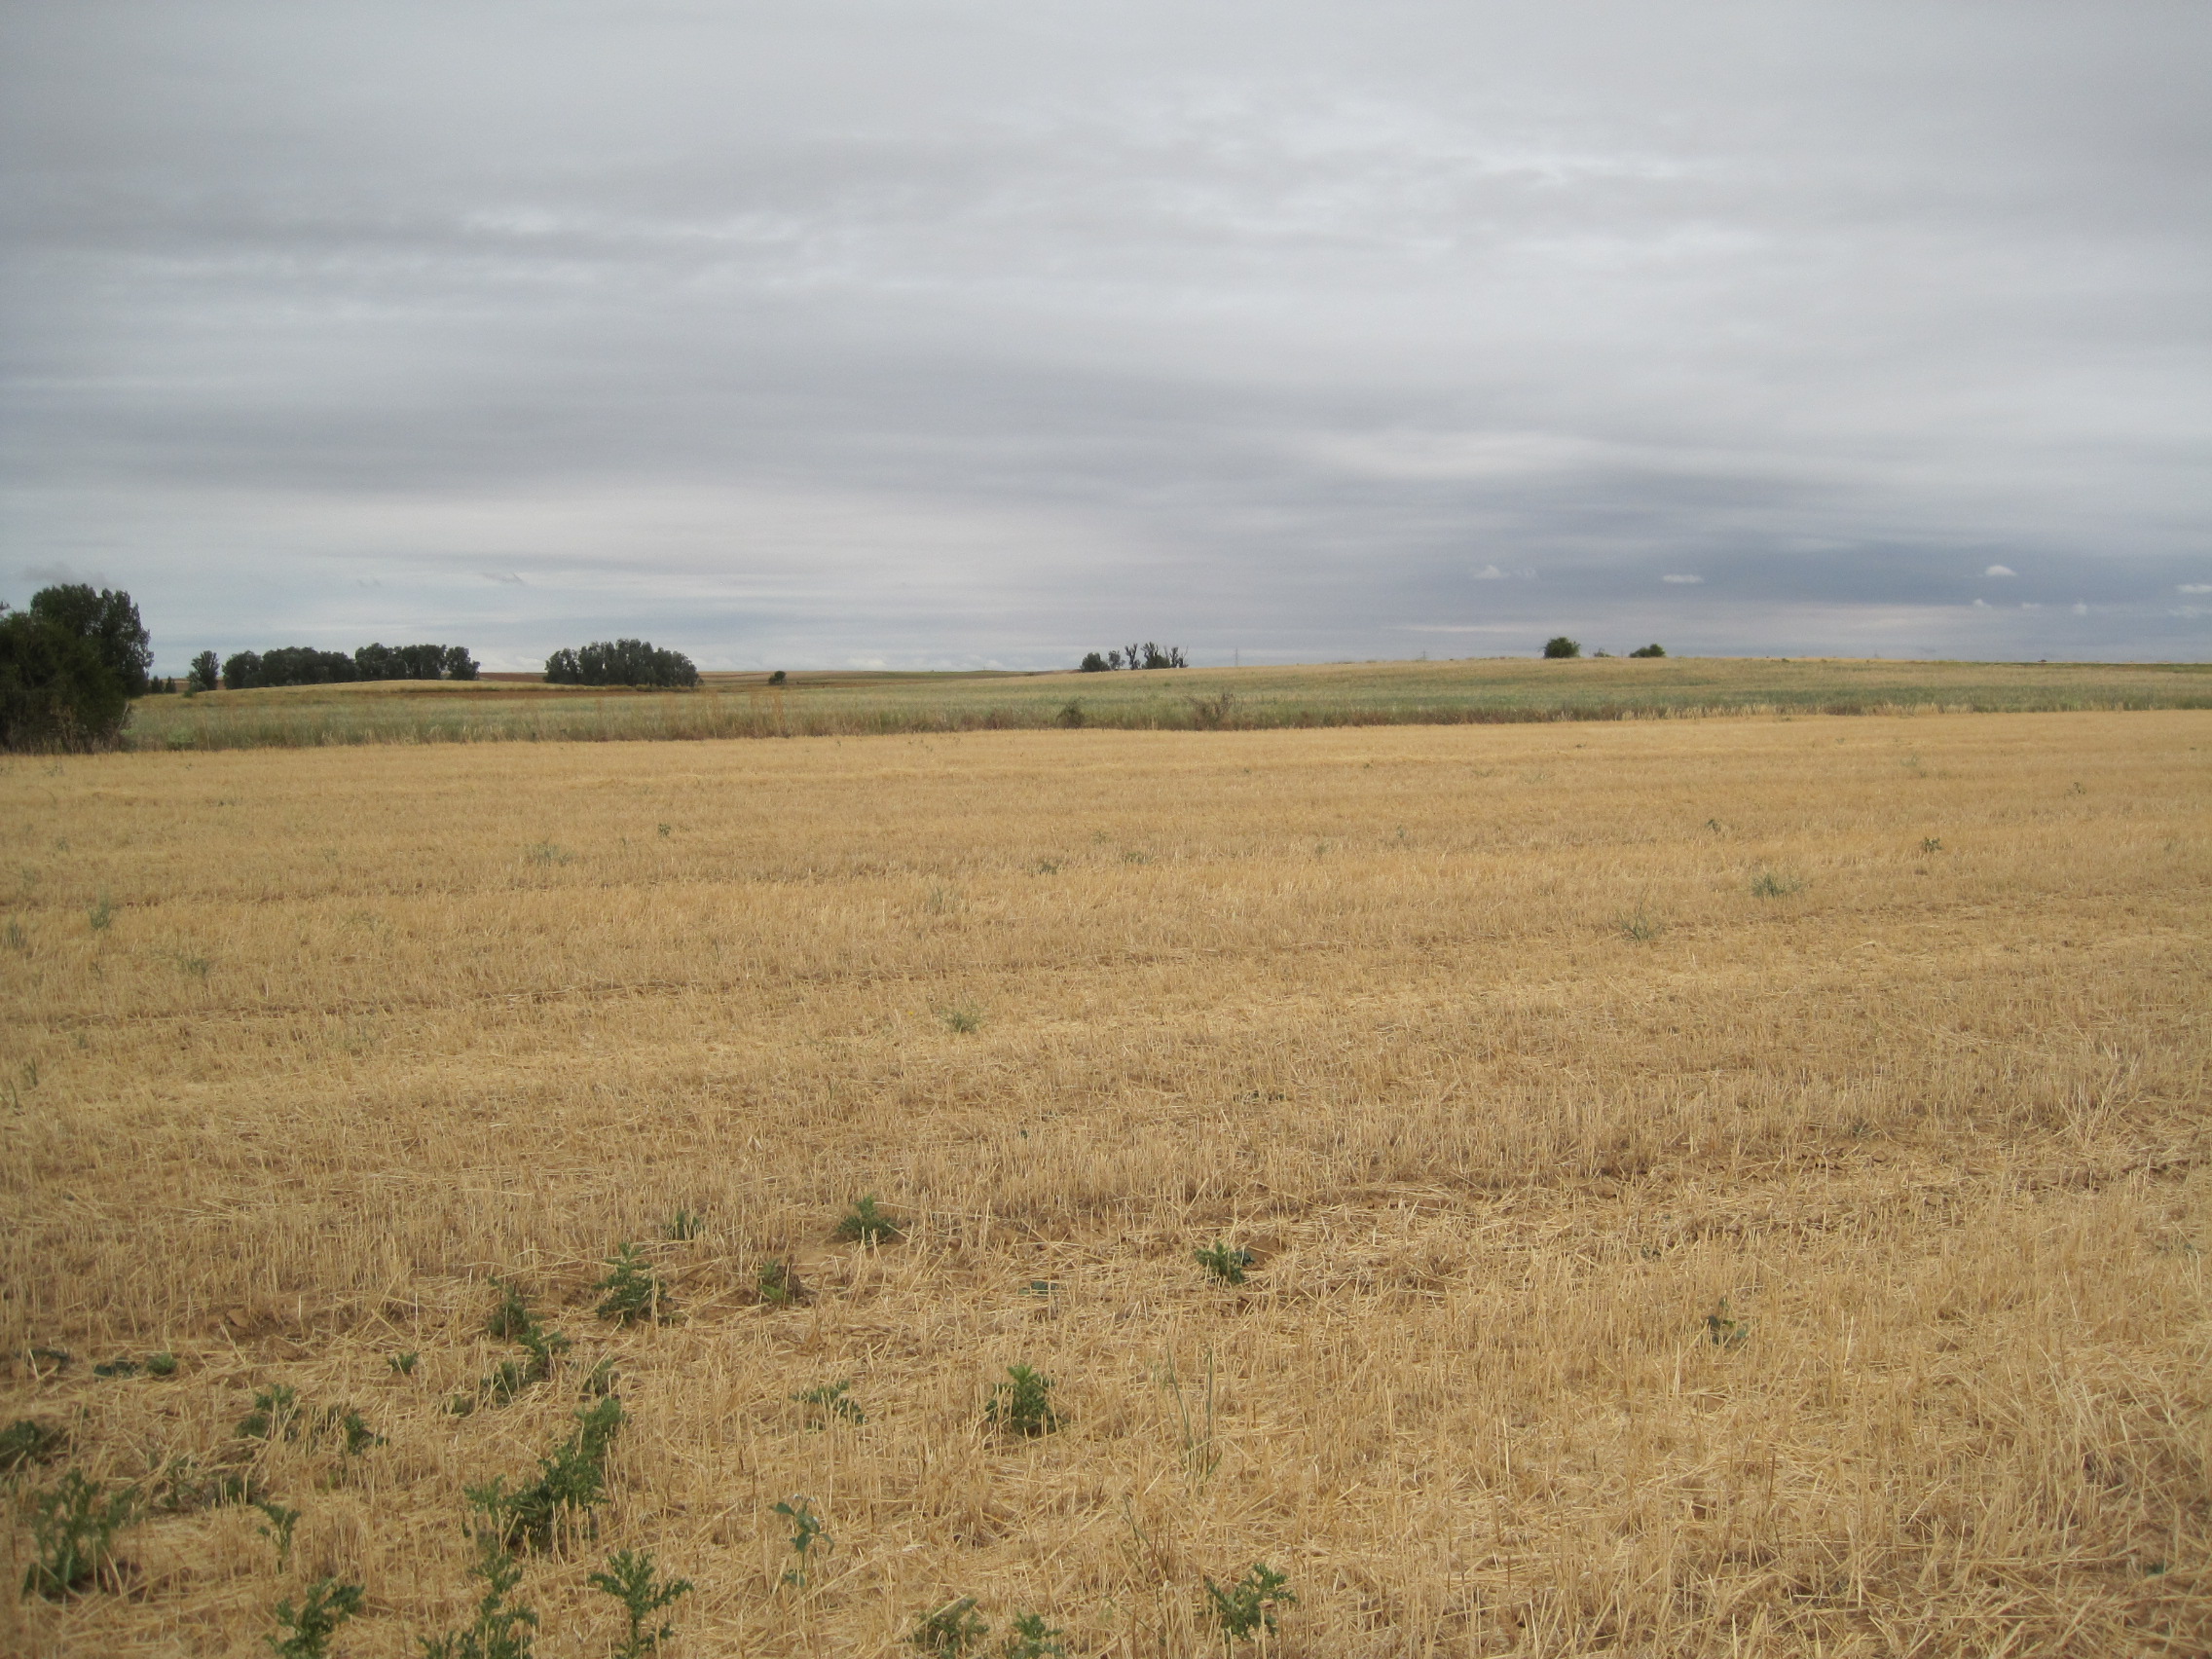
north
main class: Cropland
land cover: Barley
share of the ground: < 10 %
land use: Agriculture (excluding fallow land and kitchen gardens)
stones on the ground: < 10 %
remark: Harvested field
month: July
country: ES
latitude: 41.9956
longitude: -5.4301
